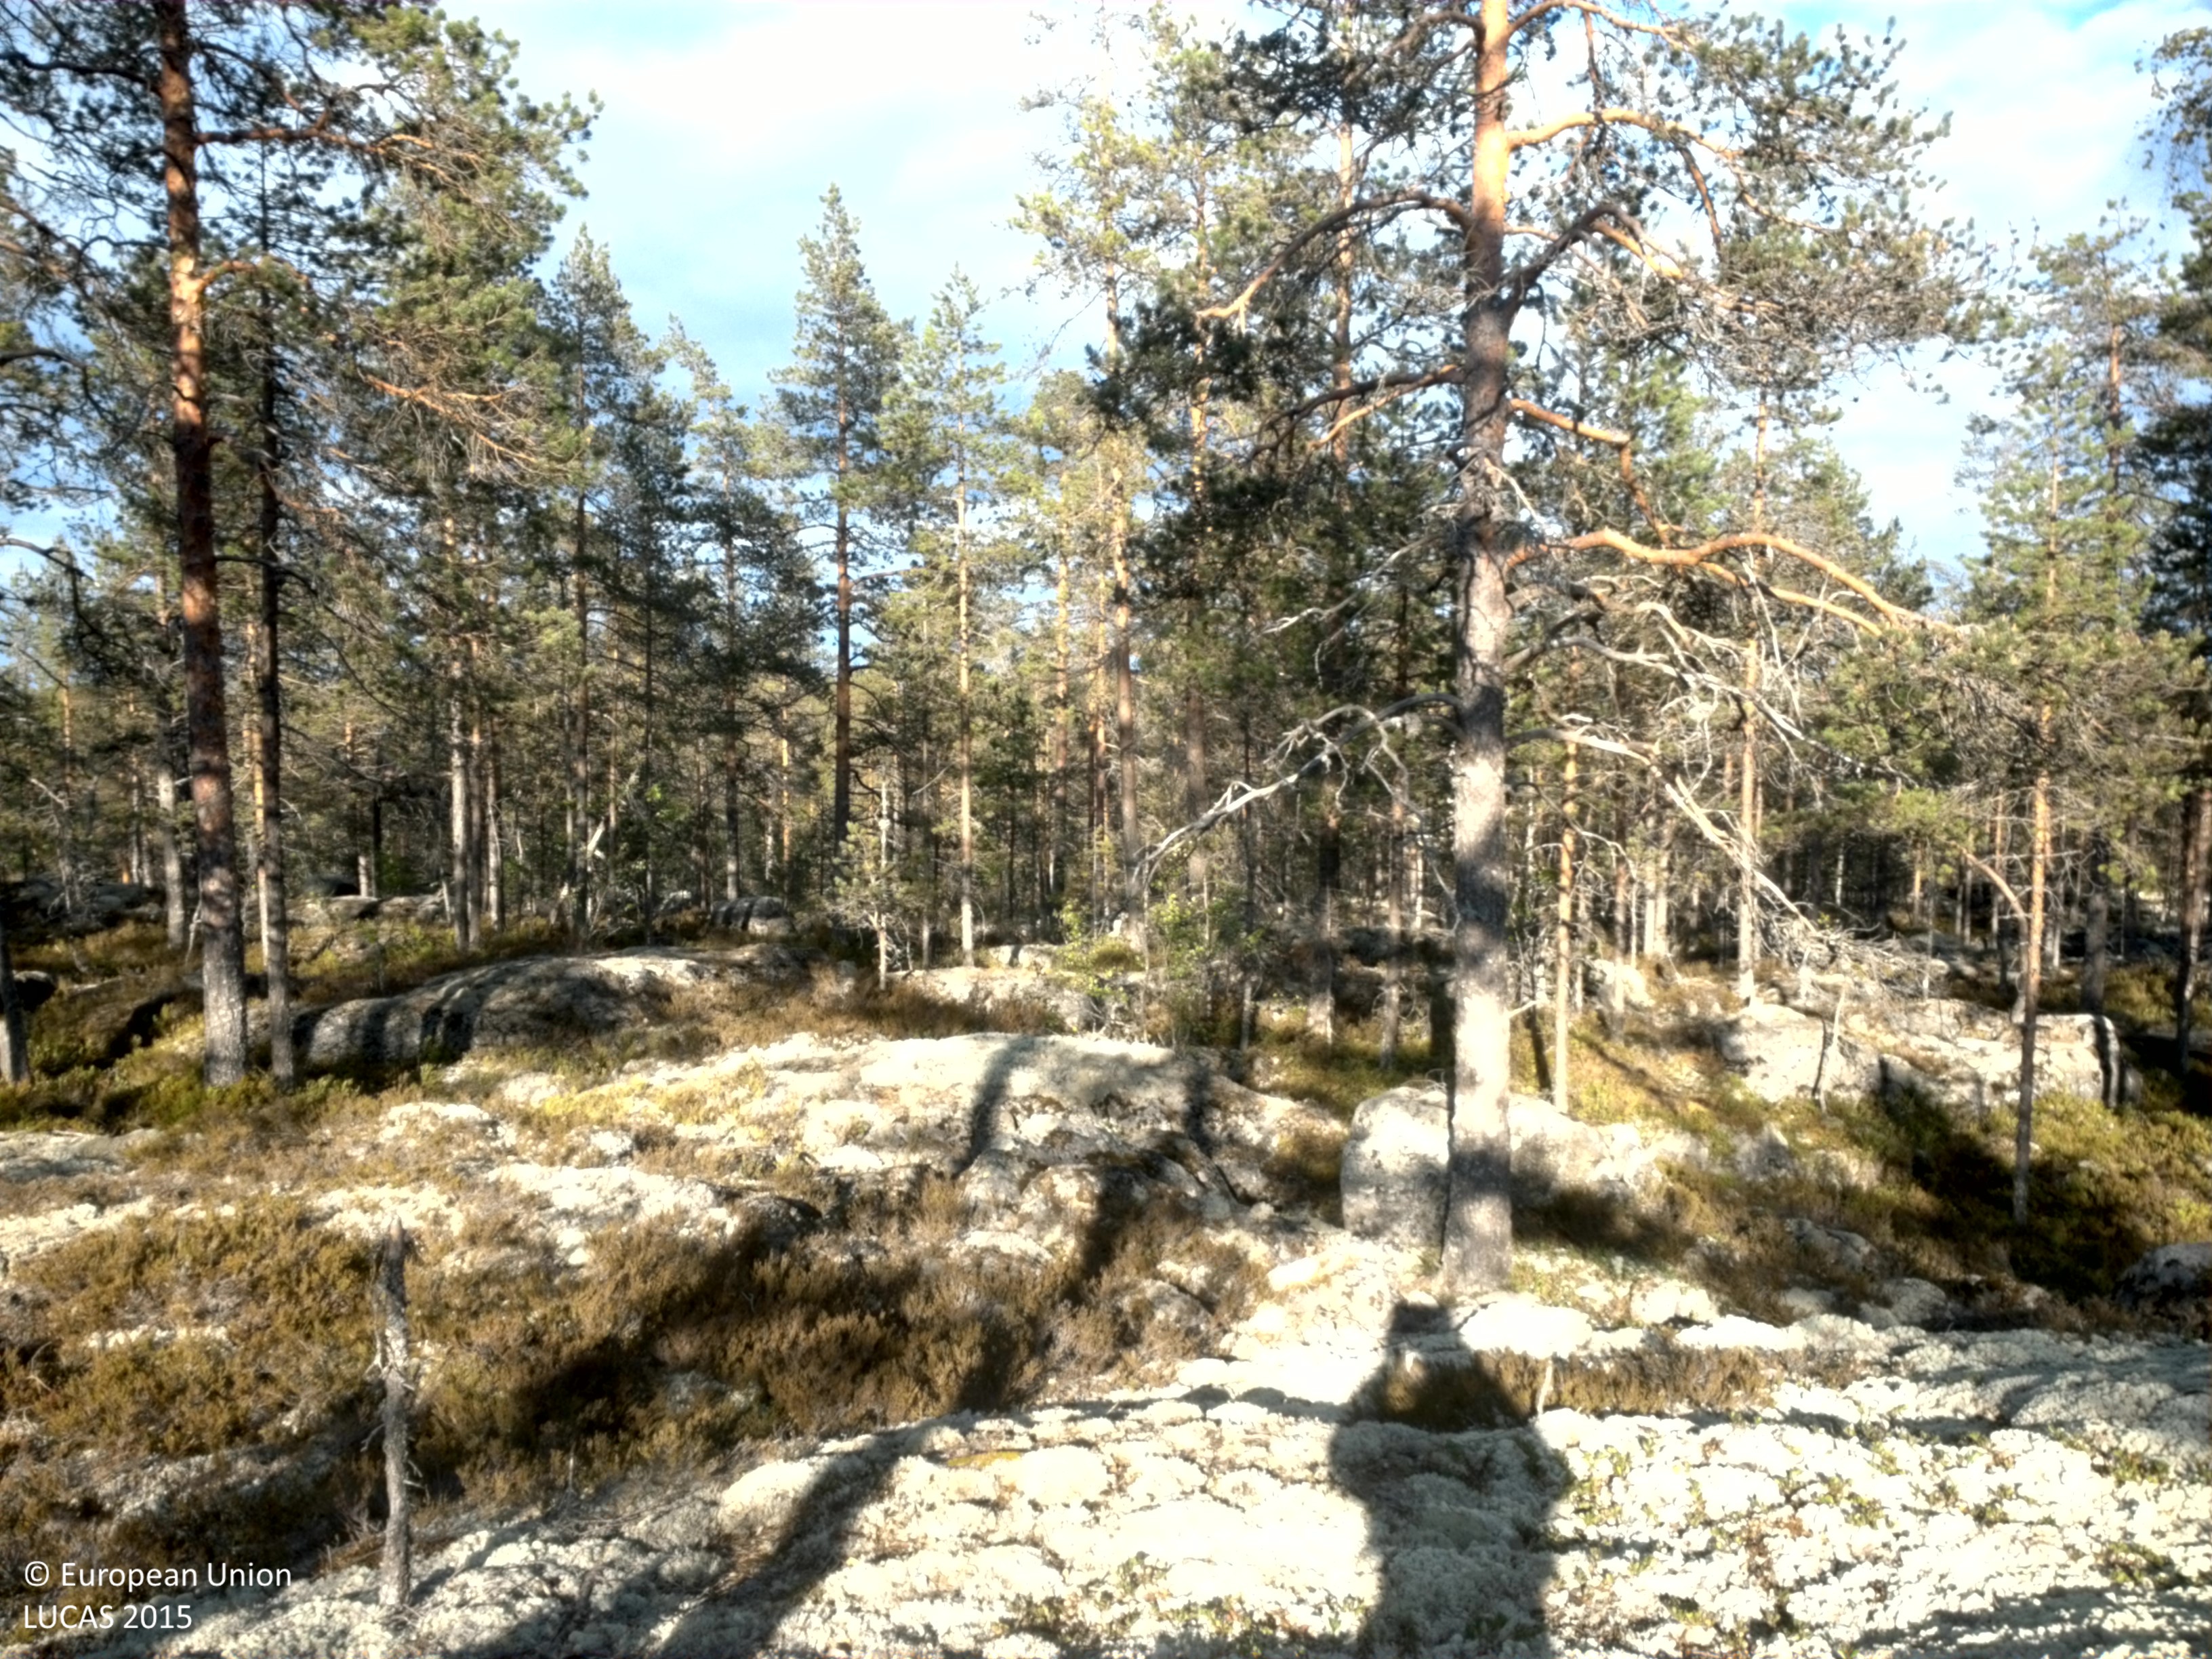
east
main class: Woodland
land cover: Pine dominated coniferous woodland
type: boreal forest
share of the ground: 25 - 50 %
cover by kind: coniferous forest trees 50 %, shrubs 20 %, lichens and mosses 20 %, consolidated bare surface 10 %
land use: Semi-natural and natural areas not in use
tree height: > 5 m
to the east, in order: Pine dominated coniferous woodland; Lichens and moss; Pine dominated coniferous woodland; Rivers and streams; Pine dominated coniferous woodland
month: June
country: SE
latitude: 63.8843
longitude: 20.5101
